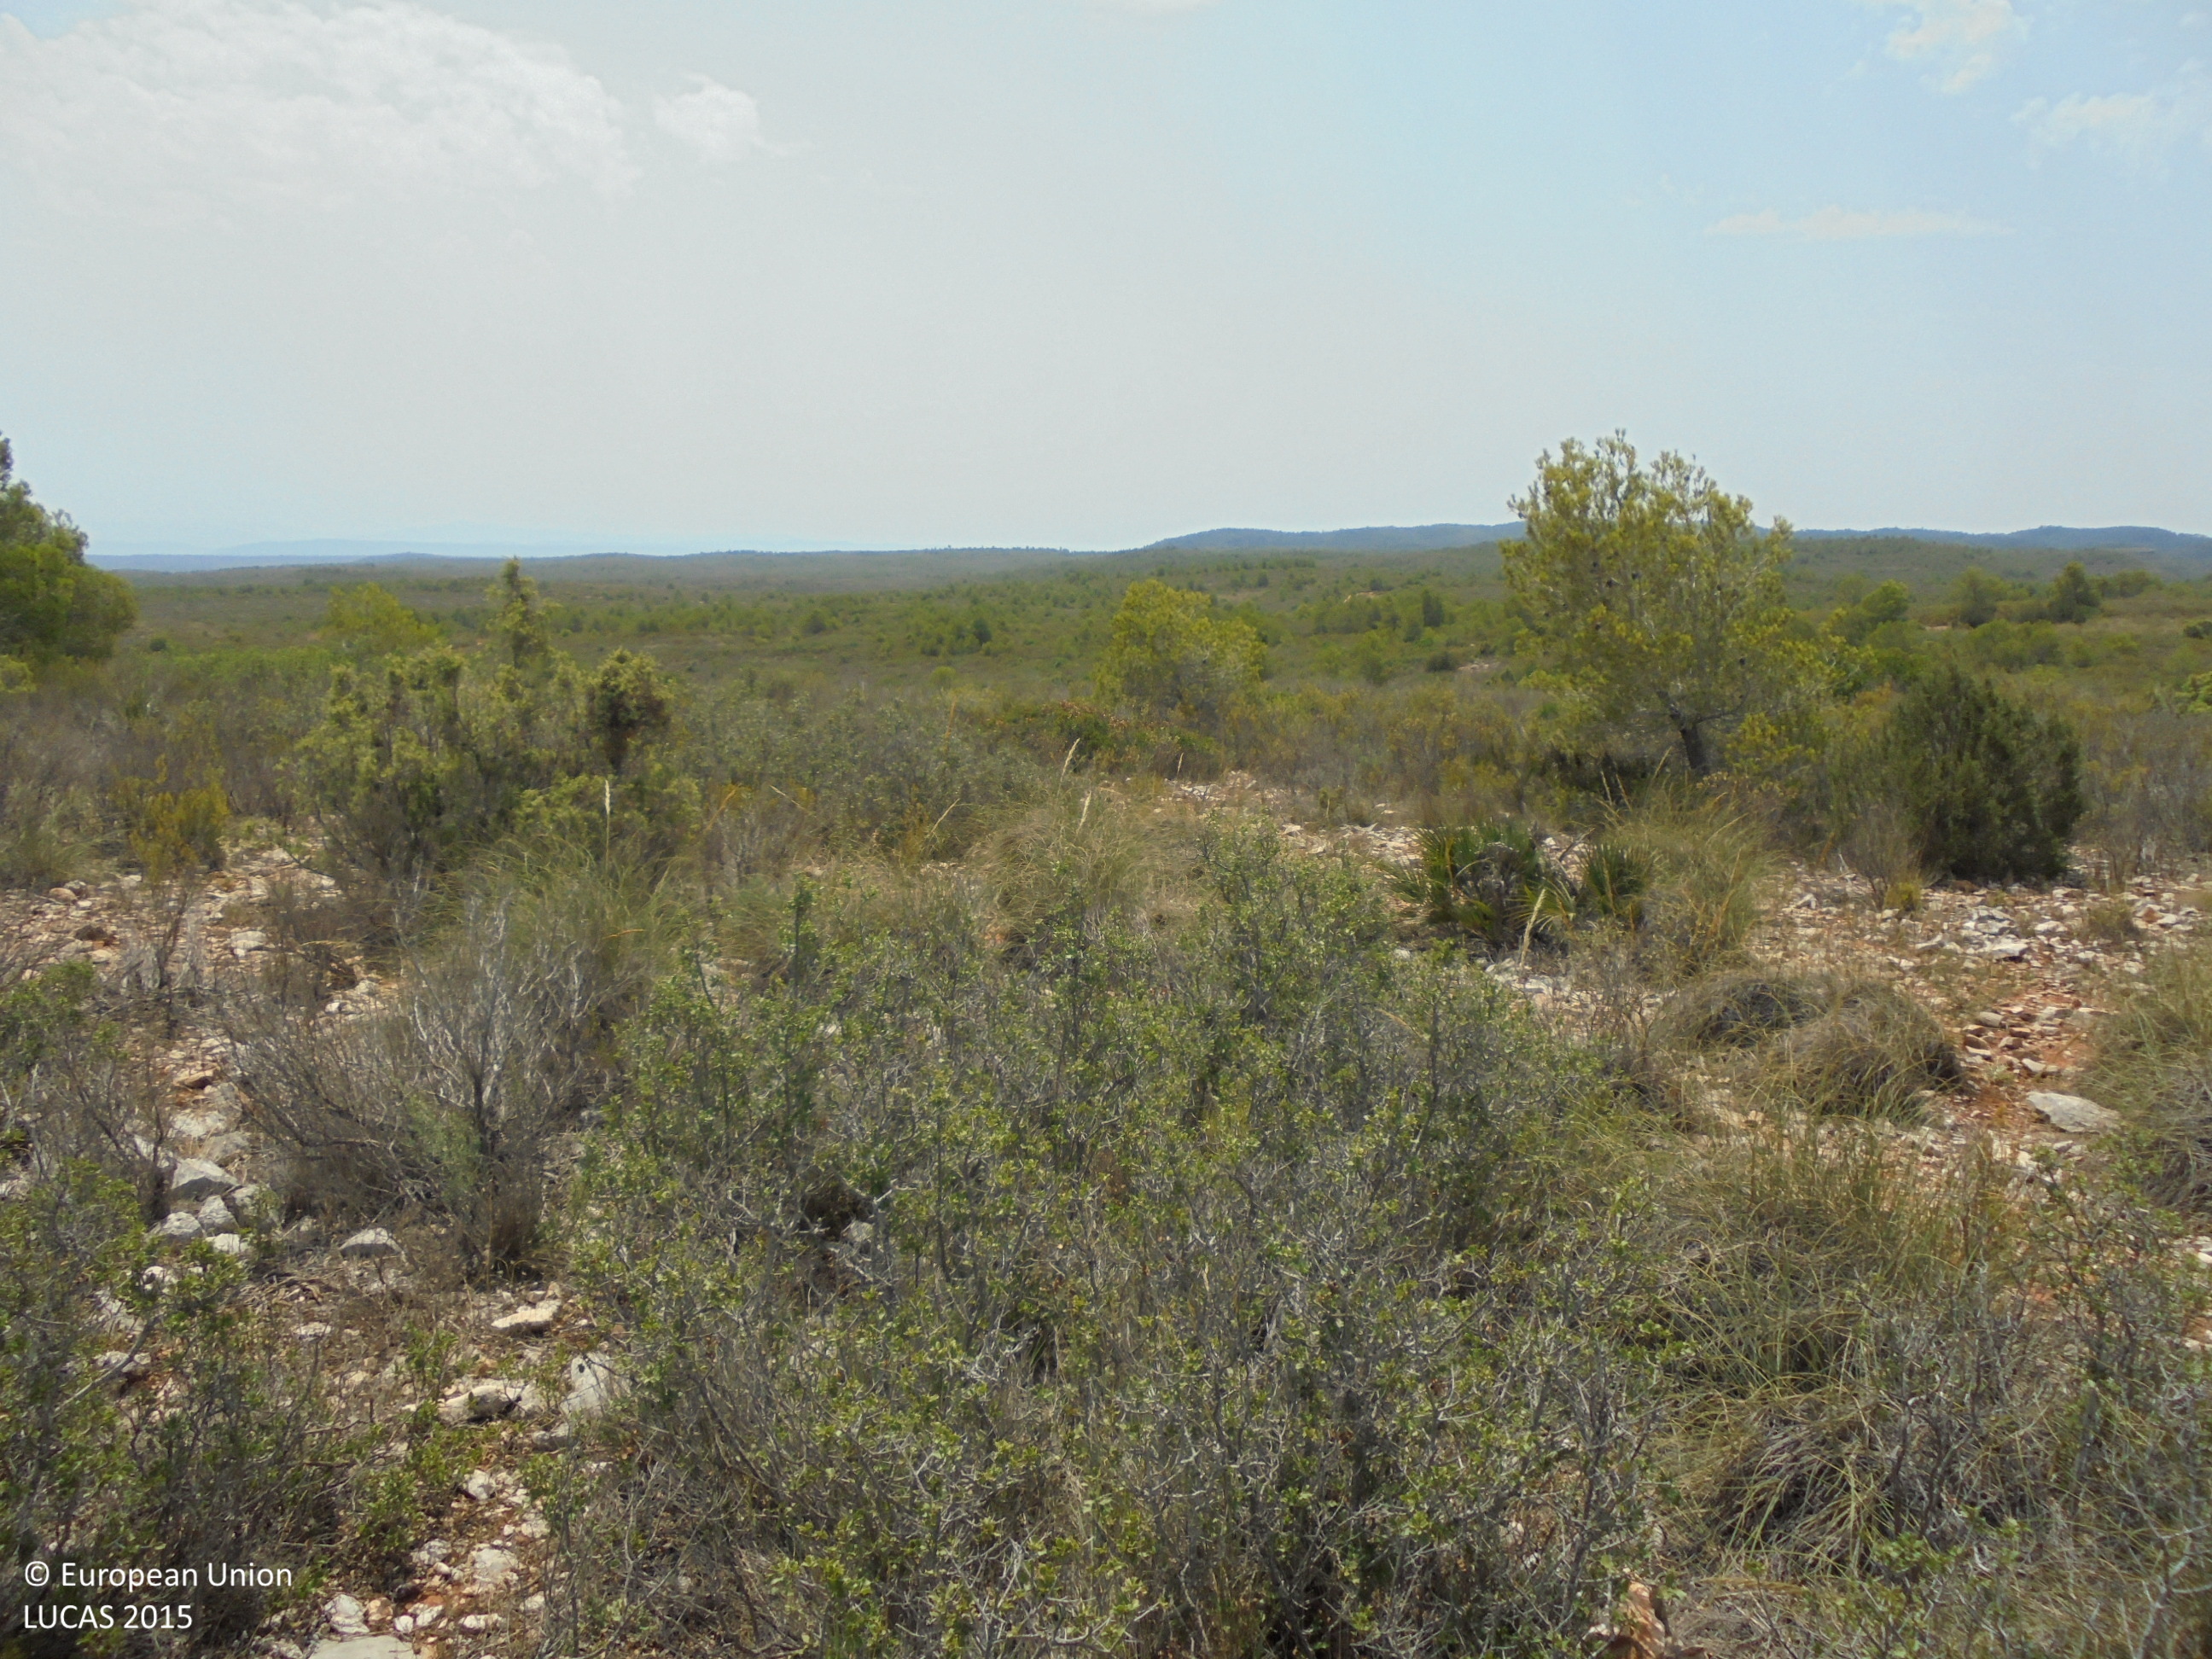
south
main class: Shrubland
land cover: Shrubland with sparse tree cover
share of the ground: > 75 %
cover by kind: shrubs 80 %, unconsolidated bare surface 15 %, coniferous forest trees 5 %
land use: Semi-natural and natural areas not in use
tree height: < 5 m
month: August
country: ES
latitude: 39.1720
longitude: -0.8418
